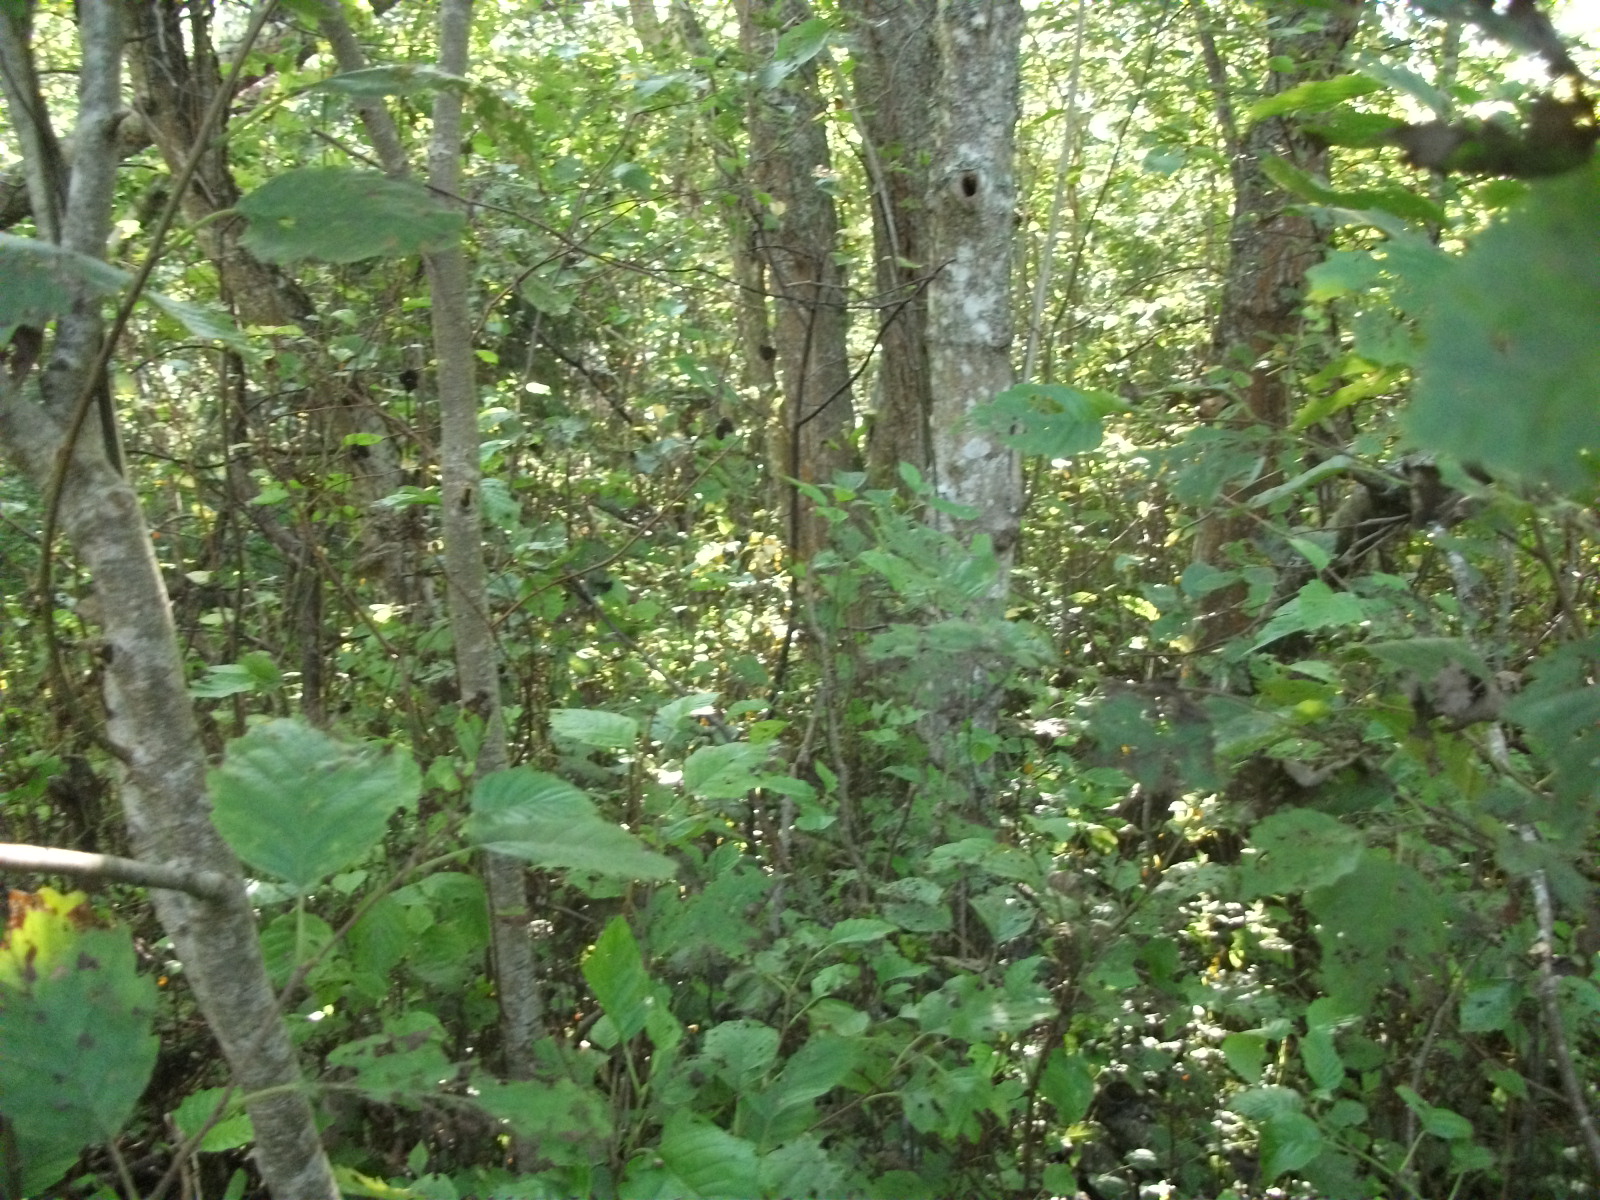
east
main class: Woodland
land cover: Broadleaved woodland
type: non-riverine alder, birch or aspen forest
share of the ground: > 75 %
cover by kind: broadleaved forest trees 80 %, shrubs 10 %, herbaceous plants 10 %
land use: Forestry
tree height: > 5 m
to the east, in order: Broadleaved woodland; Other mixed woodland; Broadleaved woodland
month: August
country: LV
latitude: 56.7209
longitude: 26.2681
